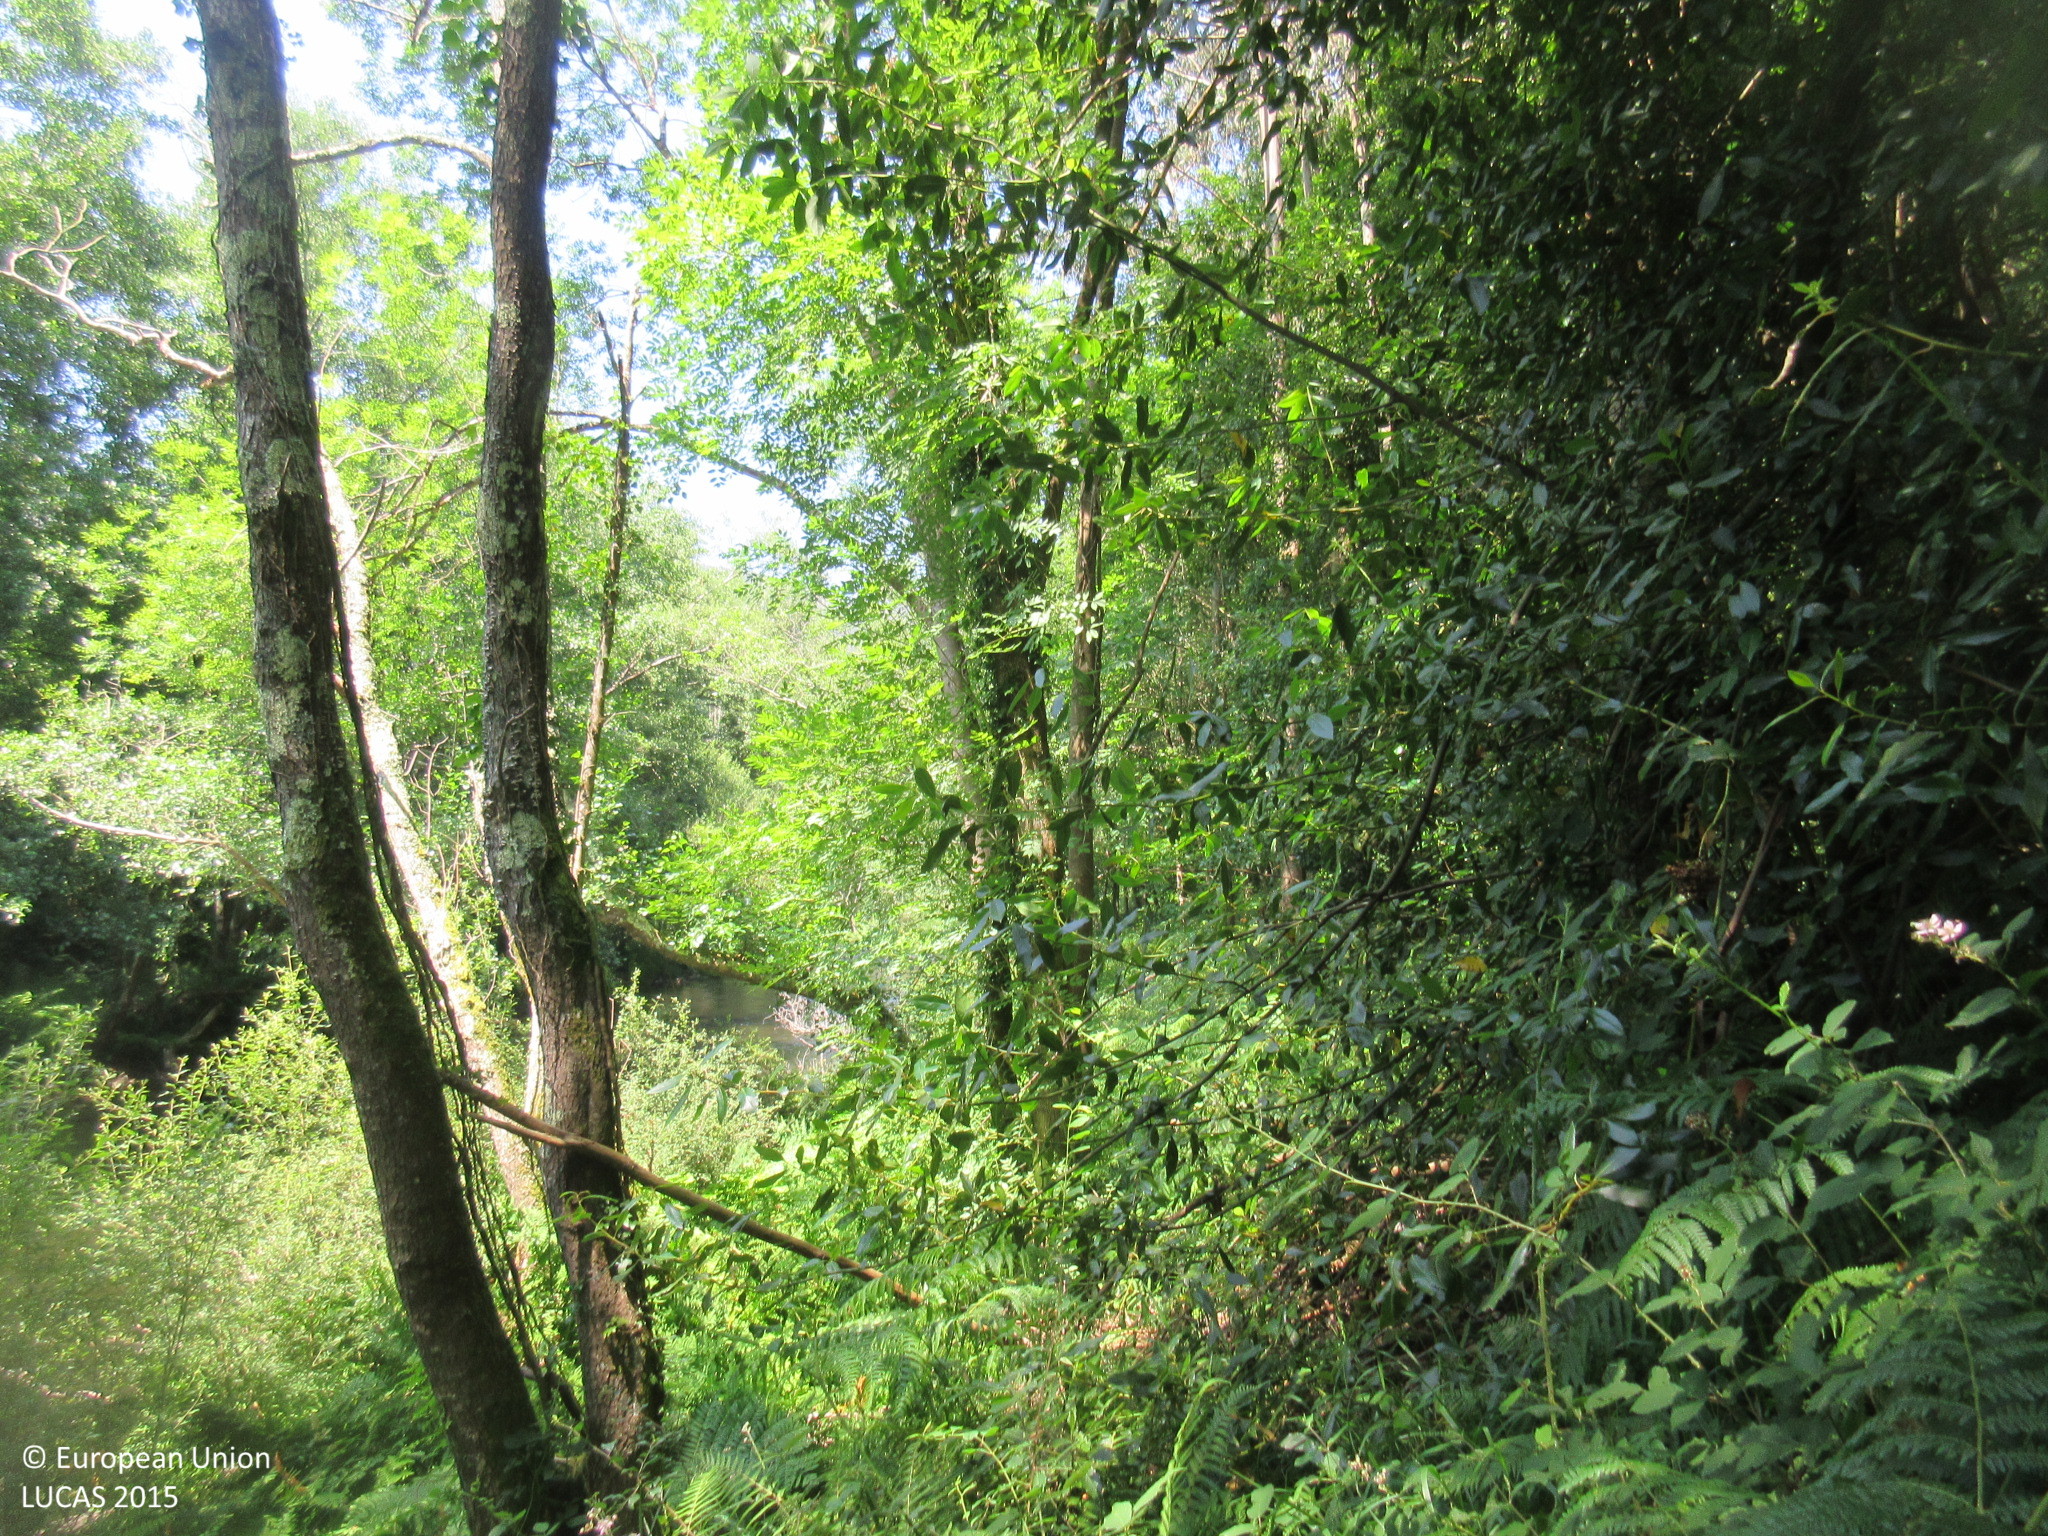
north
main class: Woodland
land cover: Broadleaved woodland
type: exotic forest
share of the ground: > 75 %
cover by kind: broadleaved forest trees 95 %, shrubs 5 %
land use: Forestry
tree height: > 5 m
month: June
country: ES
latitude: 43.4028
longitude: -7.1730
